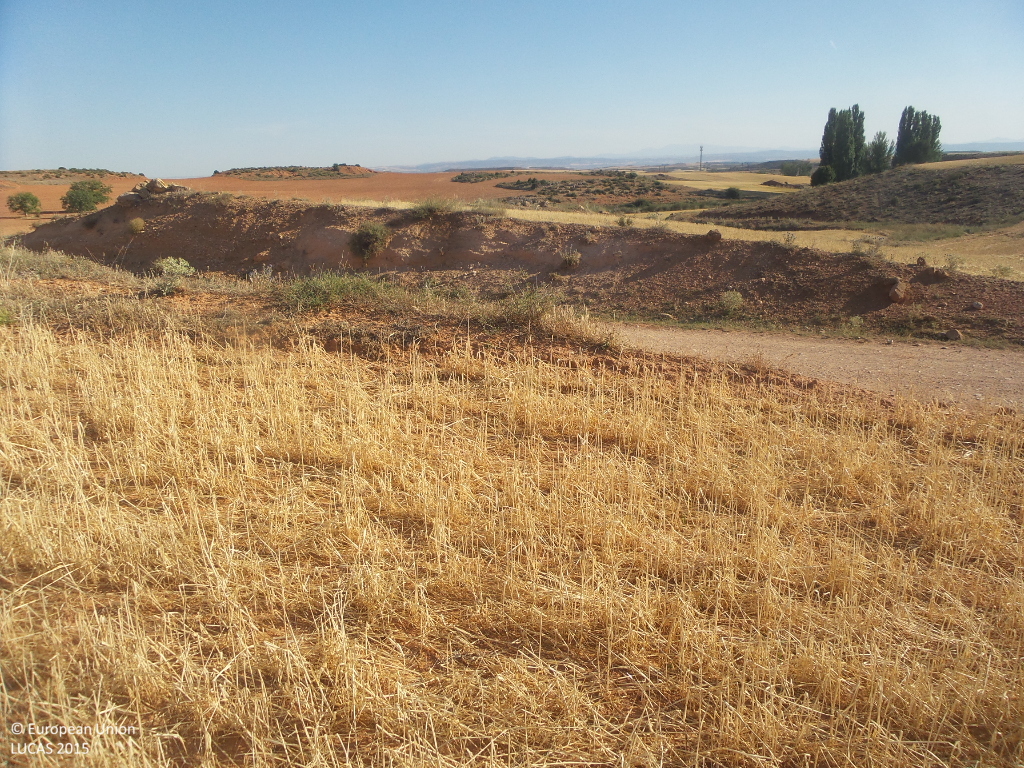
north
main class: Cropland
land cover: Barley
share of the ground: > 75 %
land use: Agriculture (excluding fallow land and kitchen gardens)
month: July
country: ES
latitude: 41.2157
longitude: -2.0868
